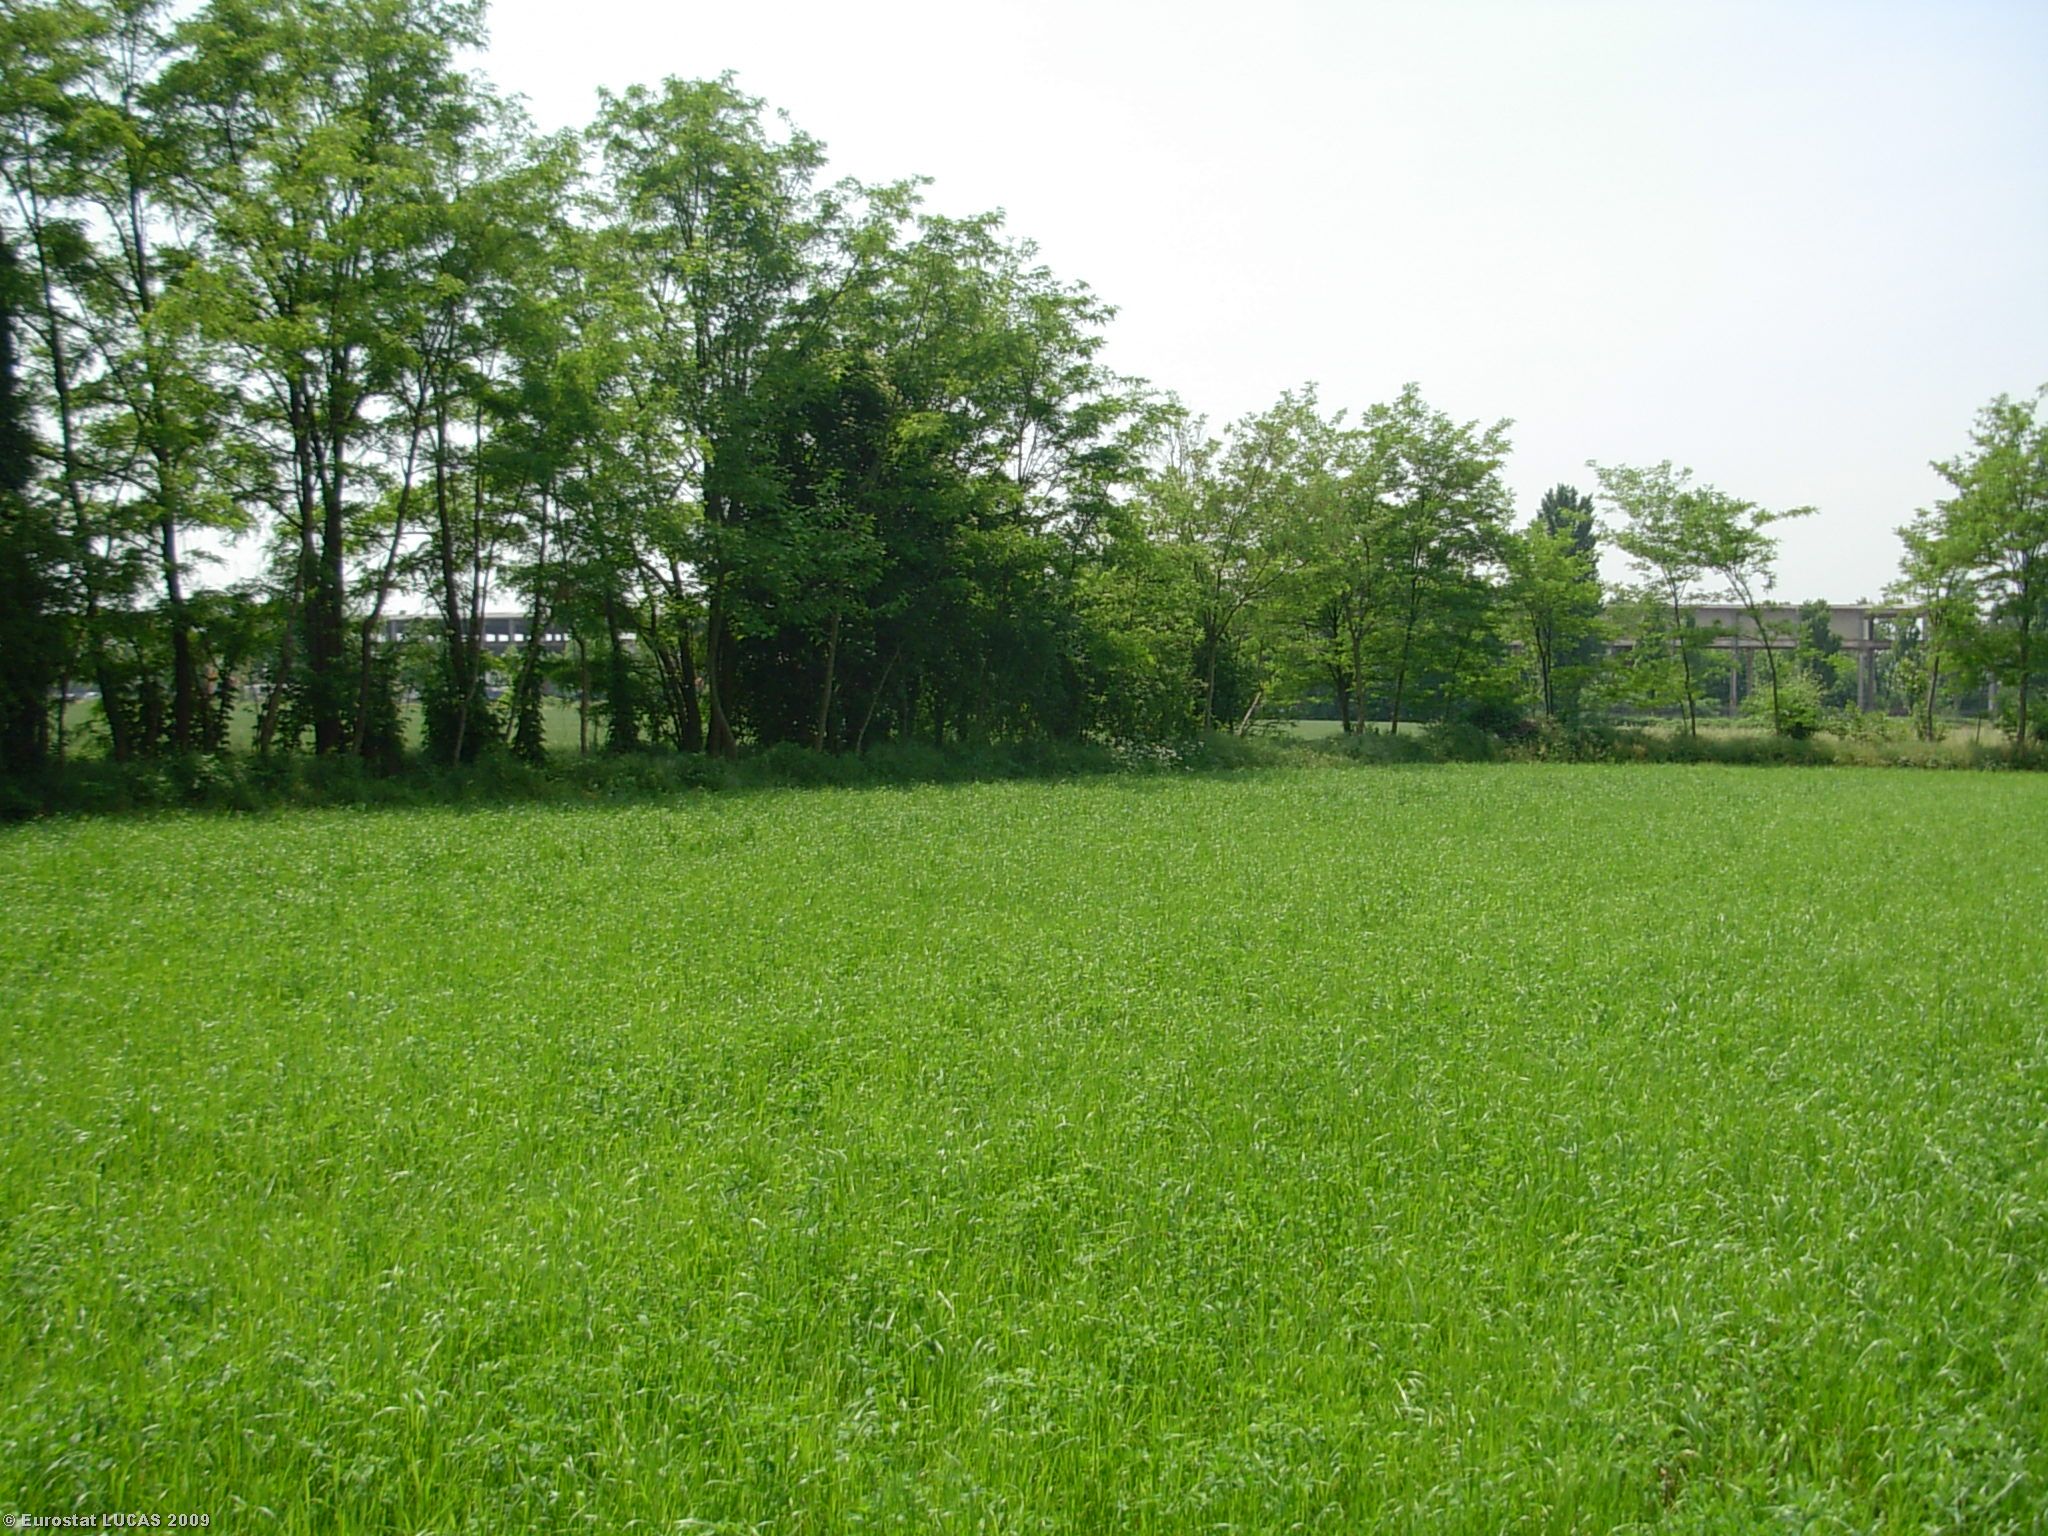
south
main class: Cropland
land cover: Lucerne
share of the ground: > 75 %
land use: Agriculture (excluding fallow land and kitchen gardens)
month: May
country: IT
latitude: 45.5039
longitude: 10.3194
